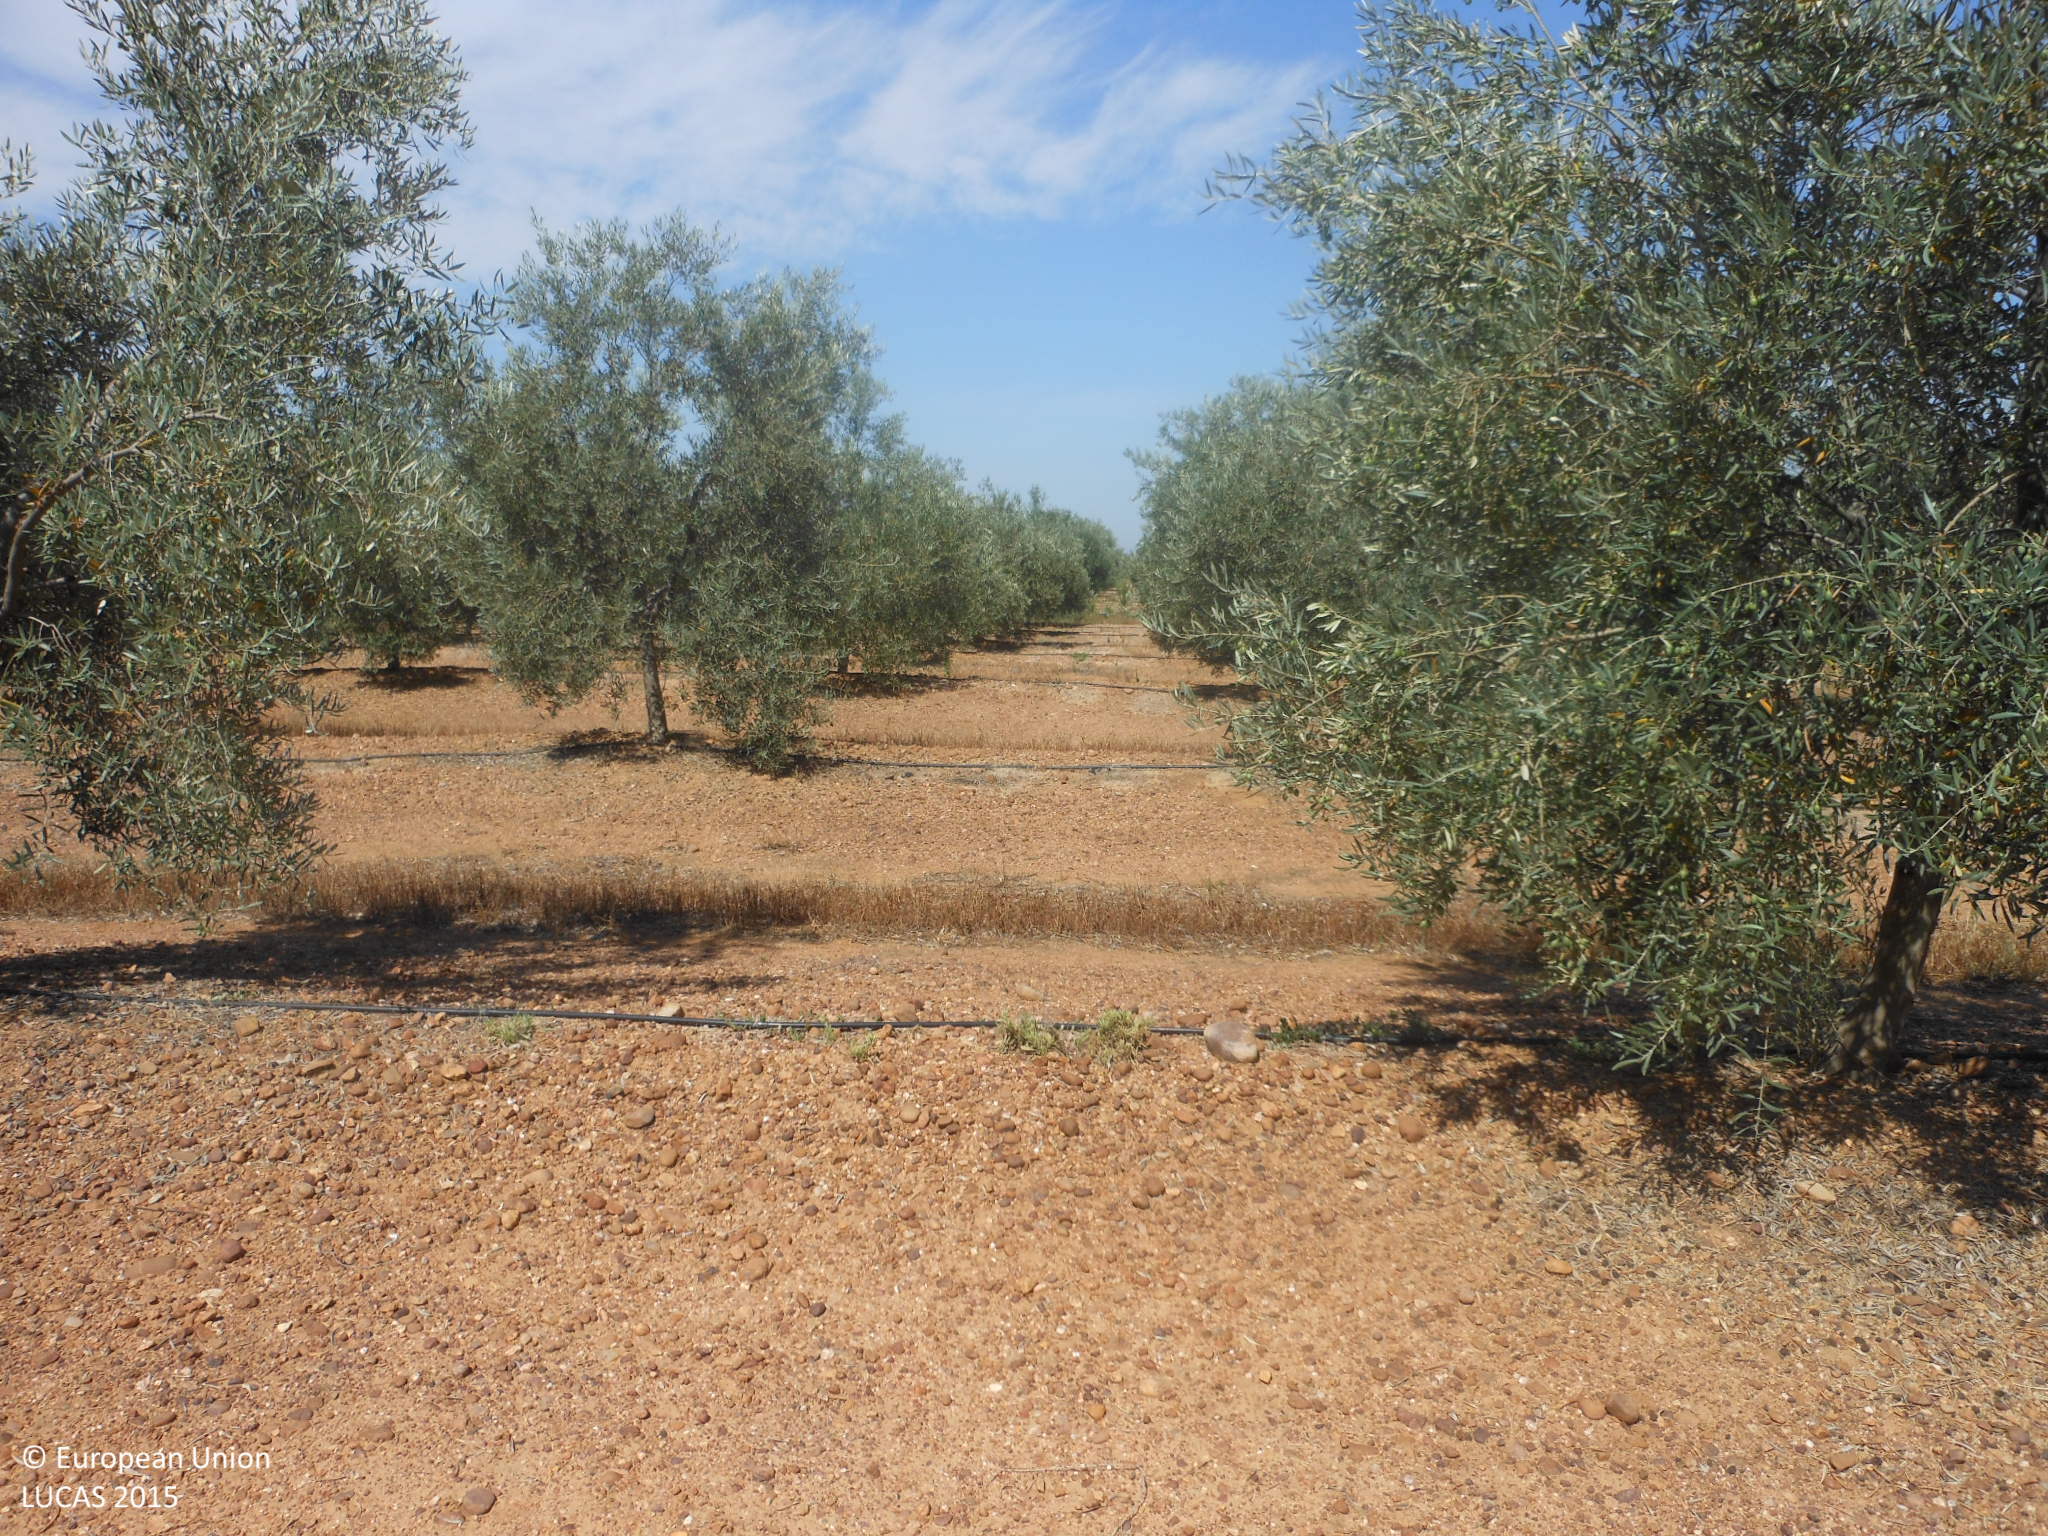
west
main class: Cropland
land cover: Olive groves
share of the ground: 50 - 75 %
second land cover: Spontaneously vegetated surfaces
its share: 10 - 25 %
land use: Agriculture (excluding fallow land and kitchen gardens)
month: June
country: ES
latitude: 37.6709
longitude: -5.1284
